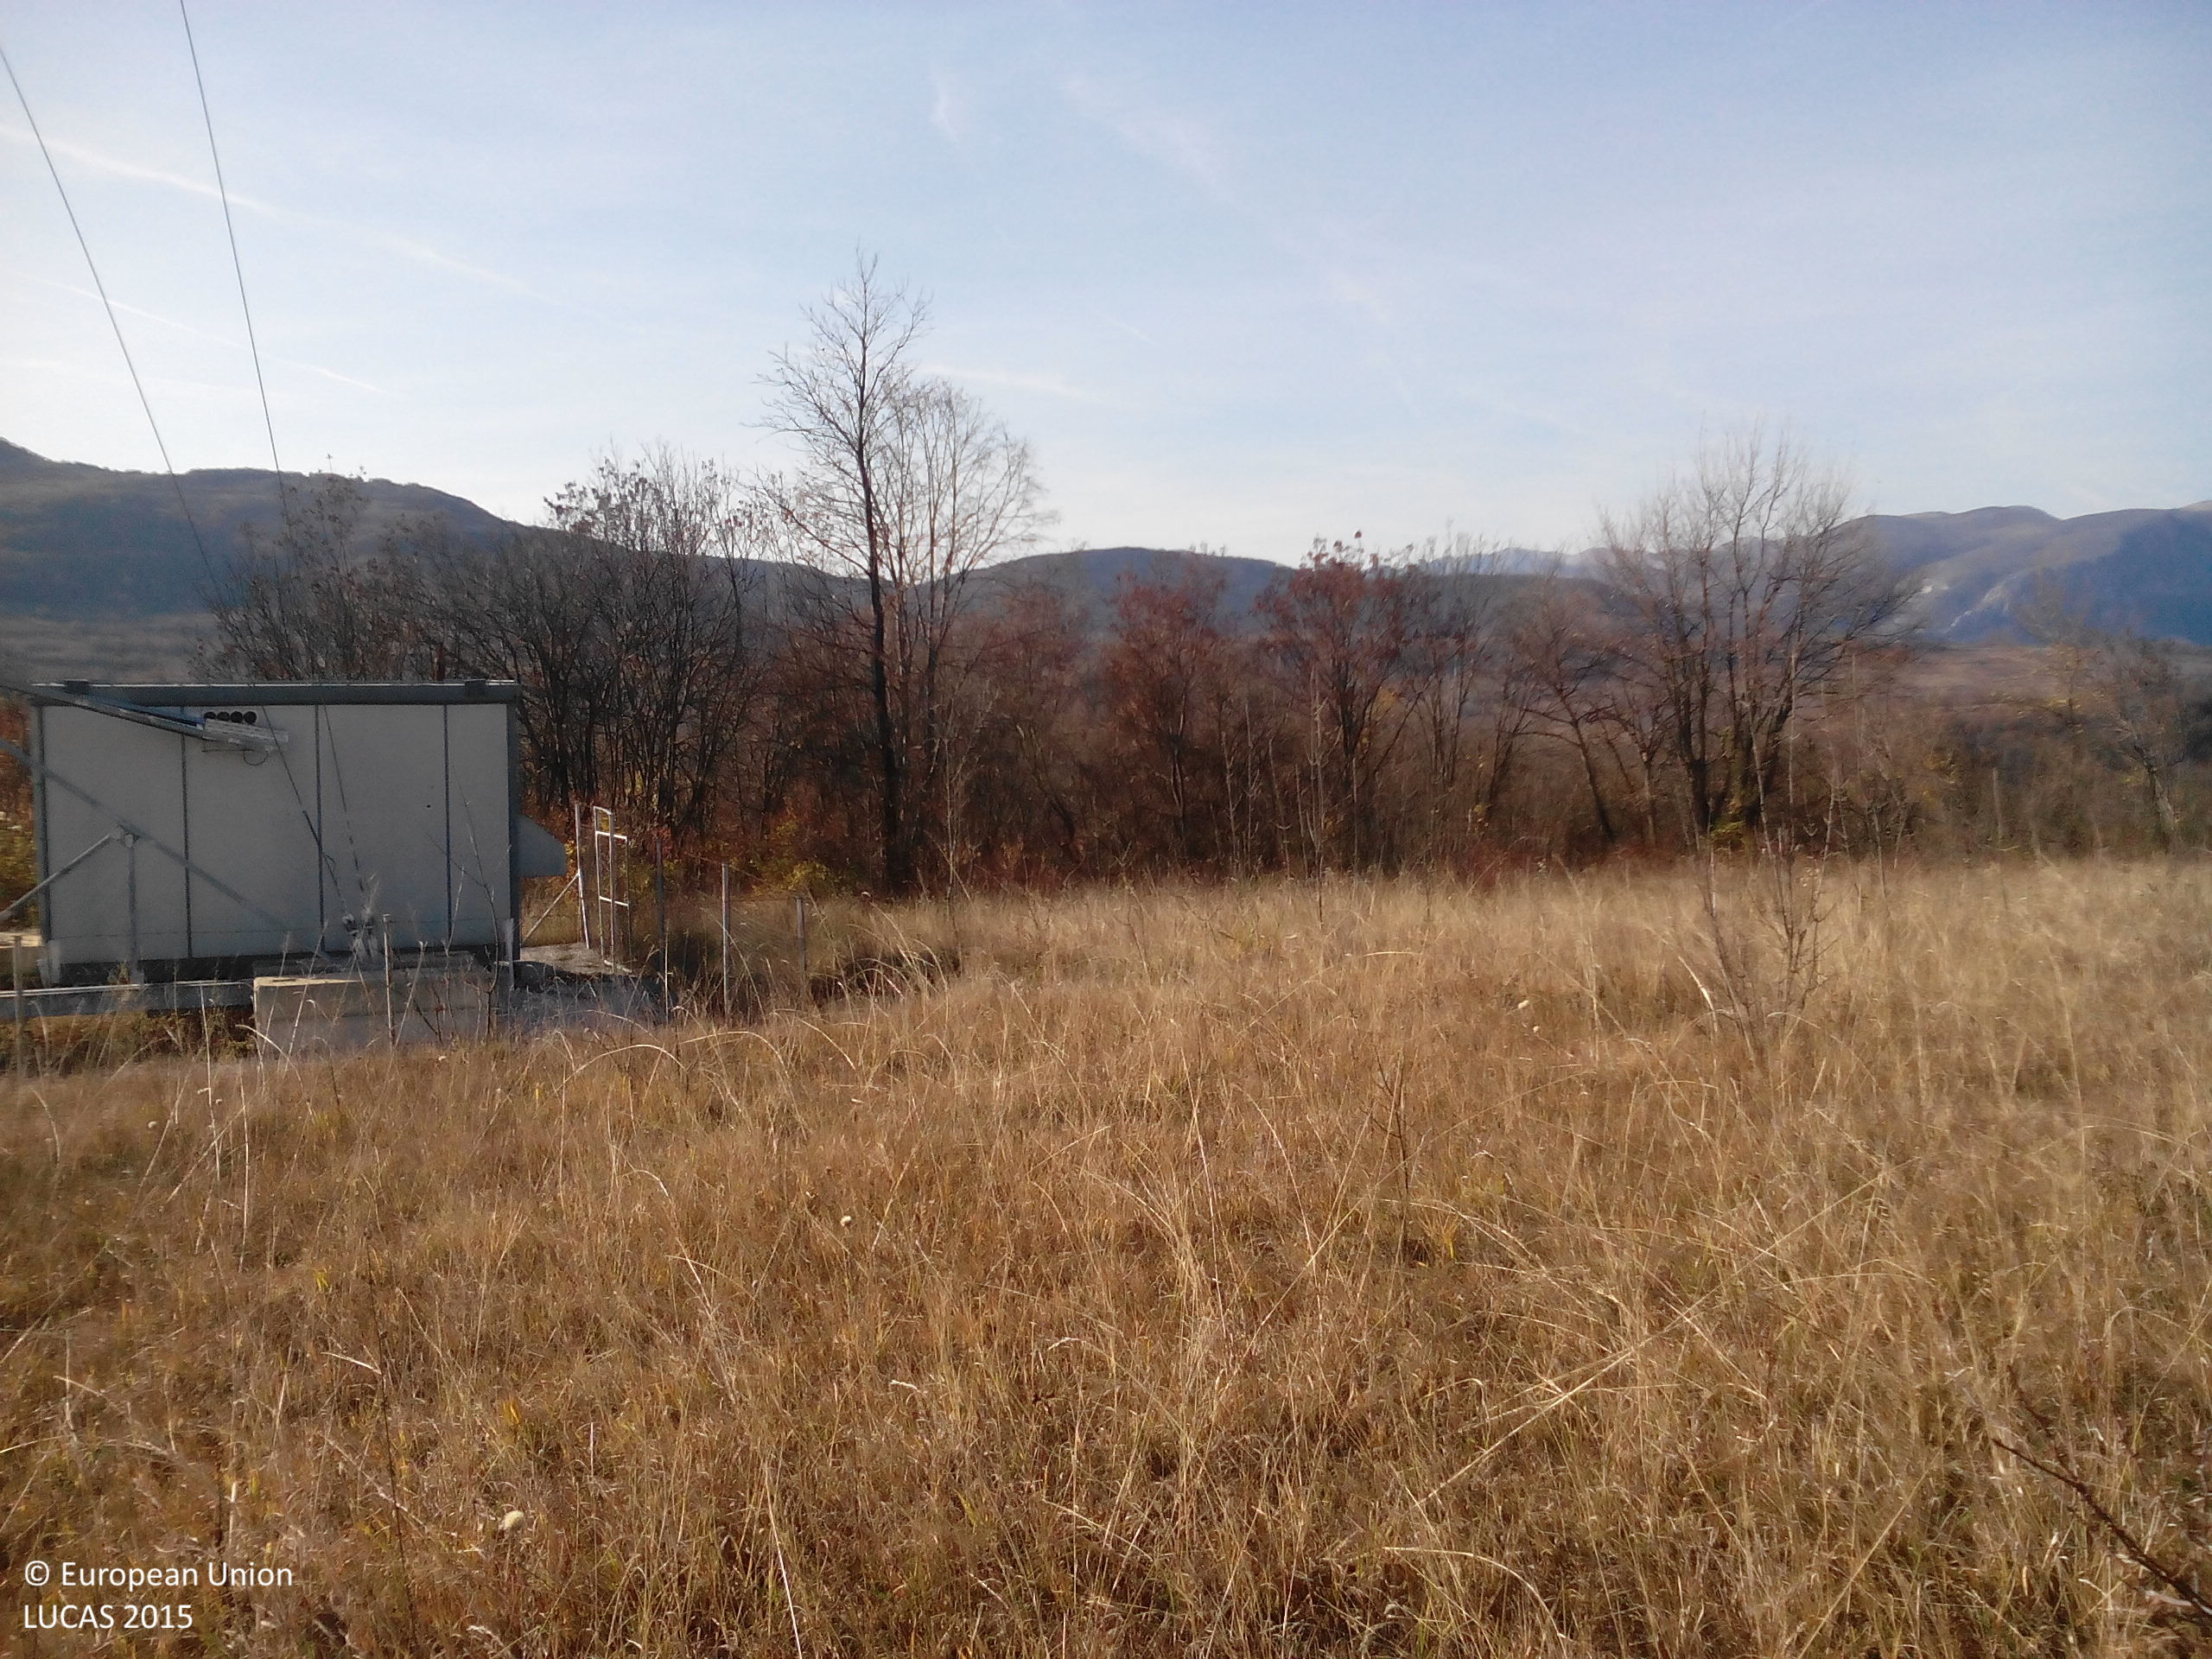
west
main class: Grassland
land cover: Grassland with sparse tree/shrub cover
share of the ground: > 75 %
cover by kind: herbaceous plants 70 %, consolidated bare surface 20 %, broadleaved forest trees 5 %, shrubs 5 %
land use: Telecommunication
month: November
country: BG
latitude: 43.0730
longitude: 23.6880
